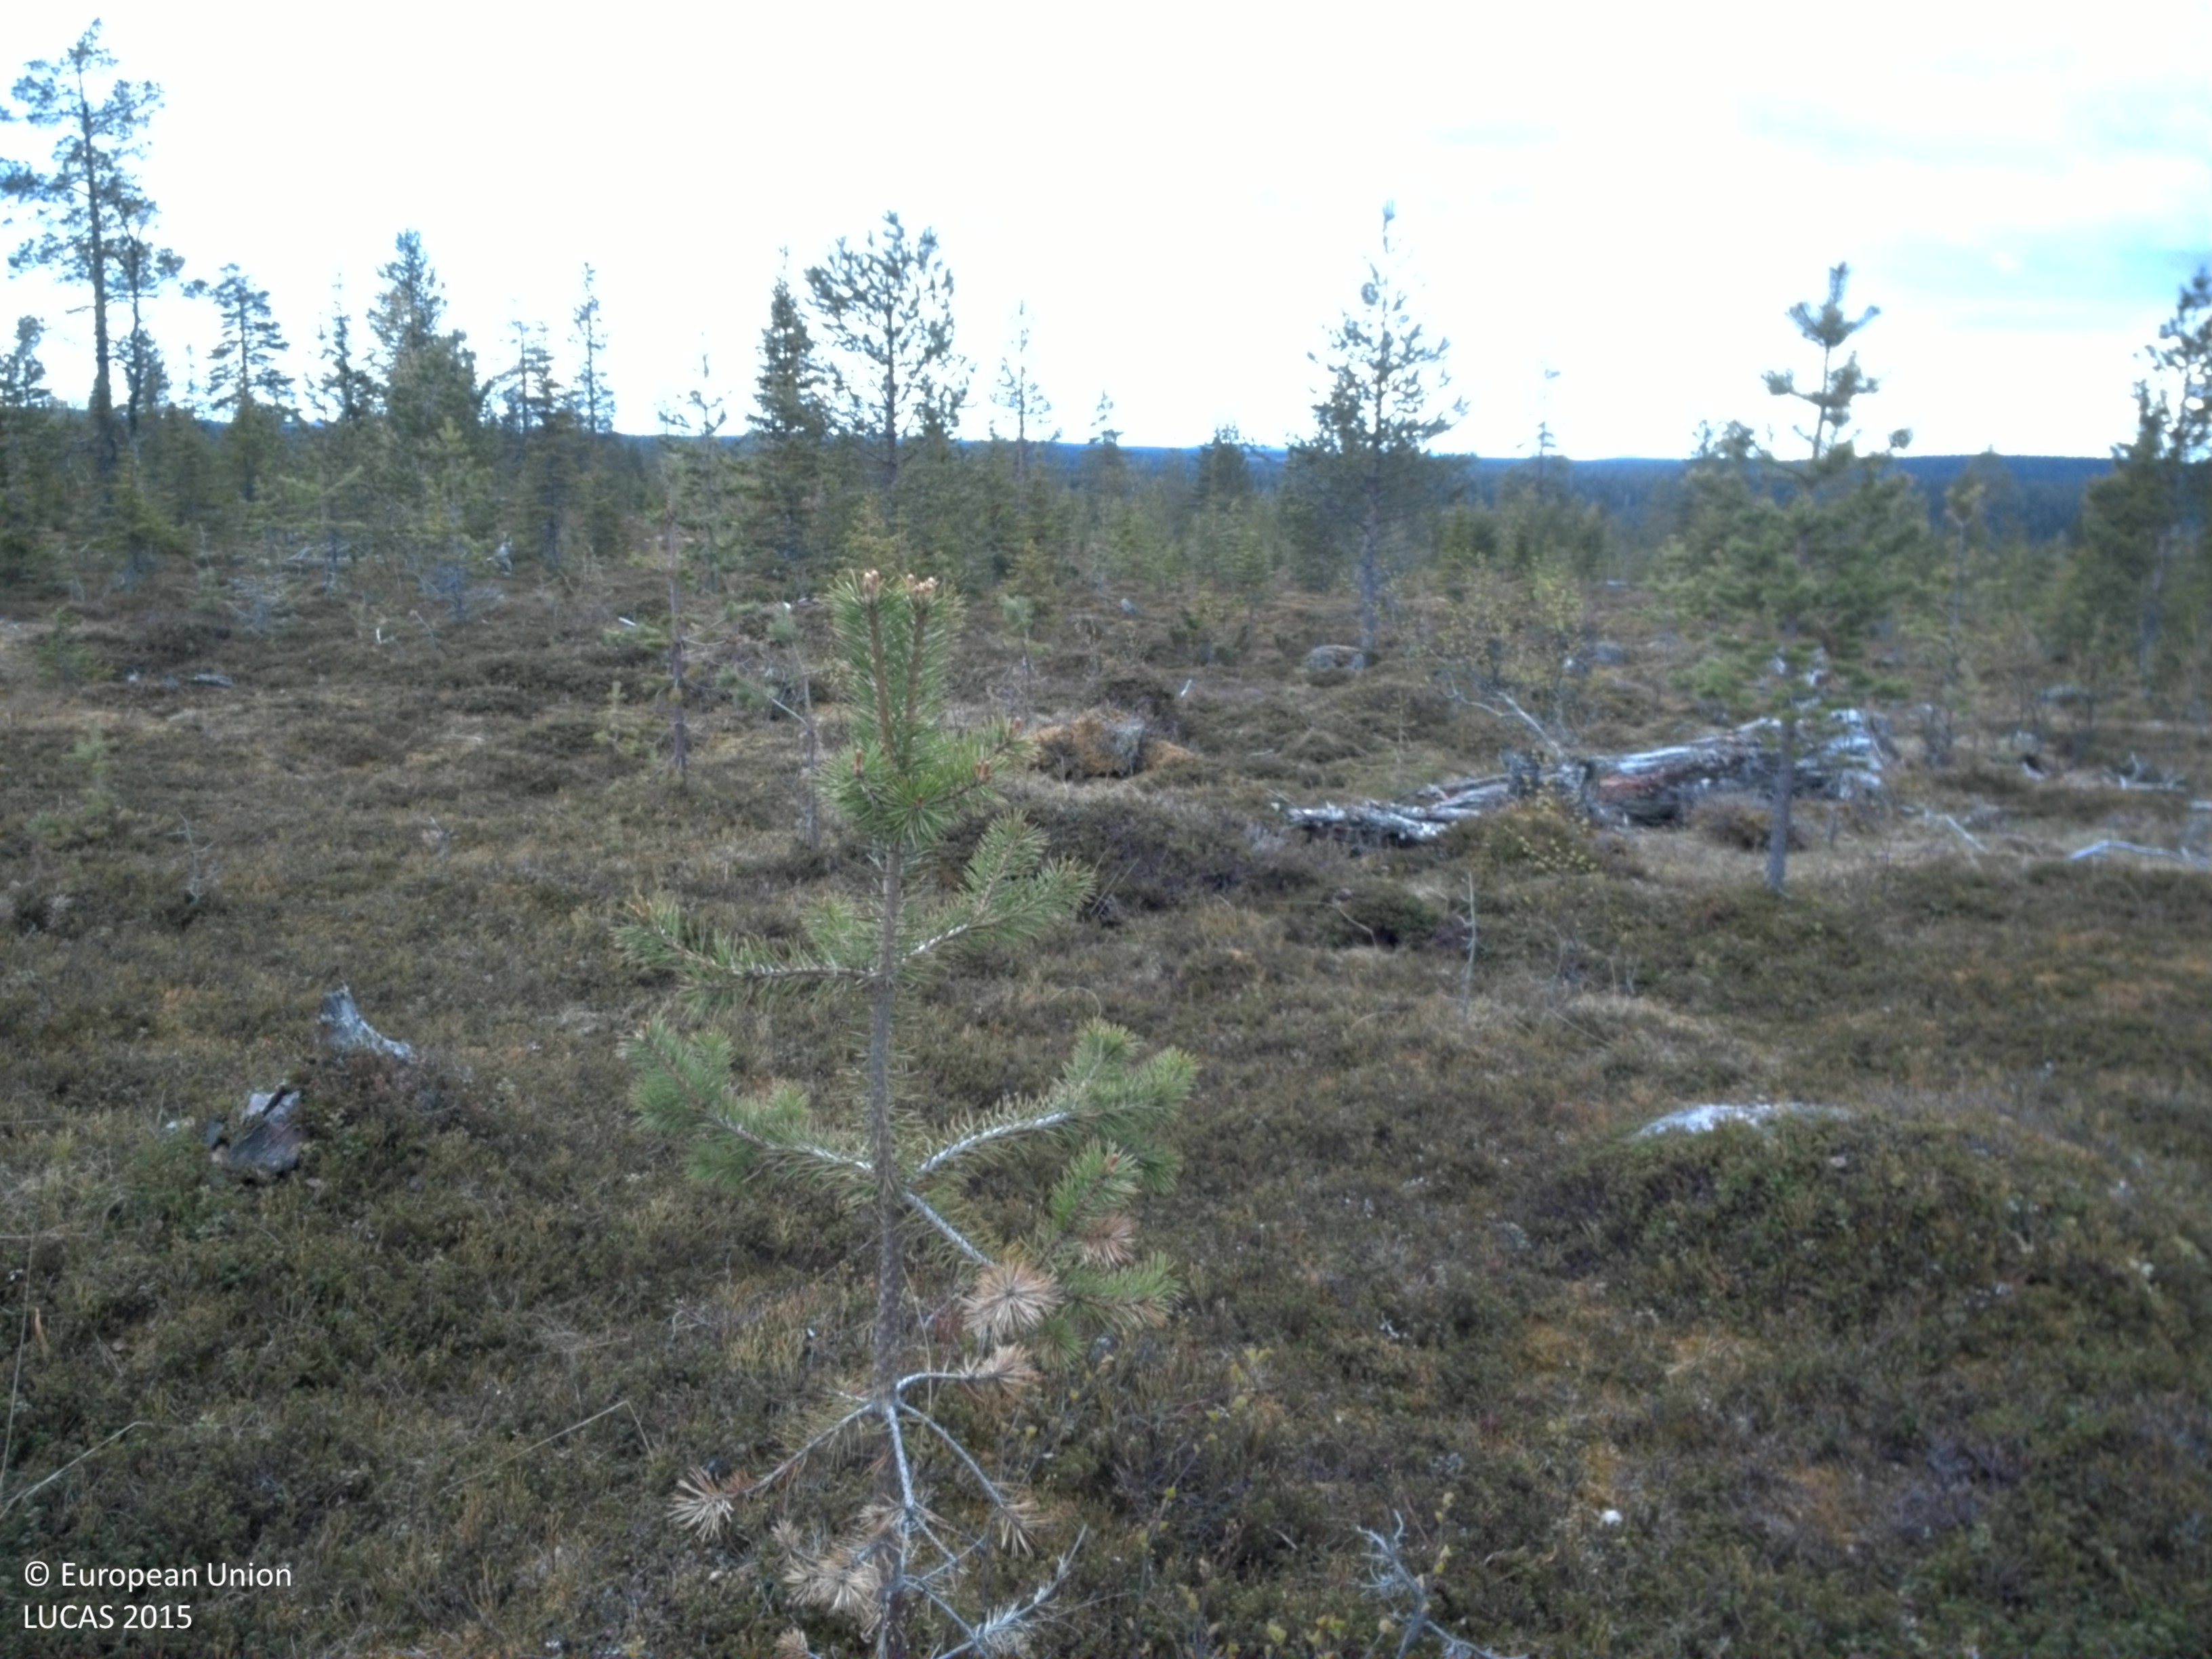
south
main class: Woodland
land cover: Pine dominated coniferous woodland
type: boreal forest
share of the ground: 10 - 25 %
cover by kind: herbaceous plants 75 %, coniferous forest trees 15 %, broadleaved forest trees 5 %, shrubs 5 %
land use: Forestry
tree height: > 5 m
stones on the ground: < 10 %
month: June
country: SE
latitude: 67.0157
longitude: 20.9914
